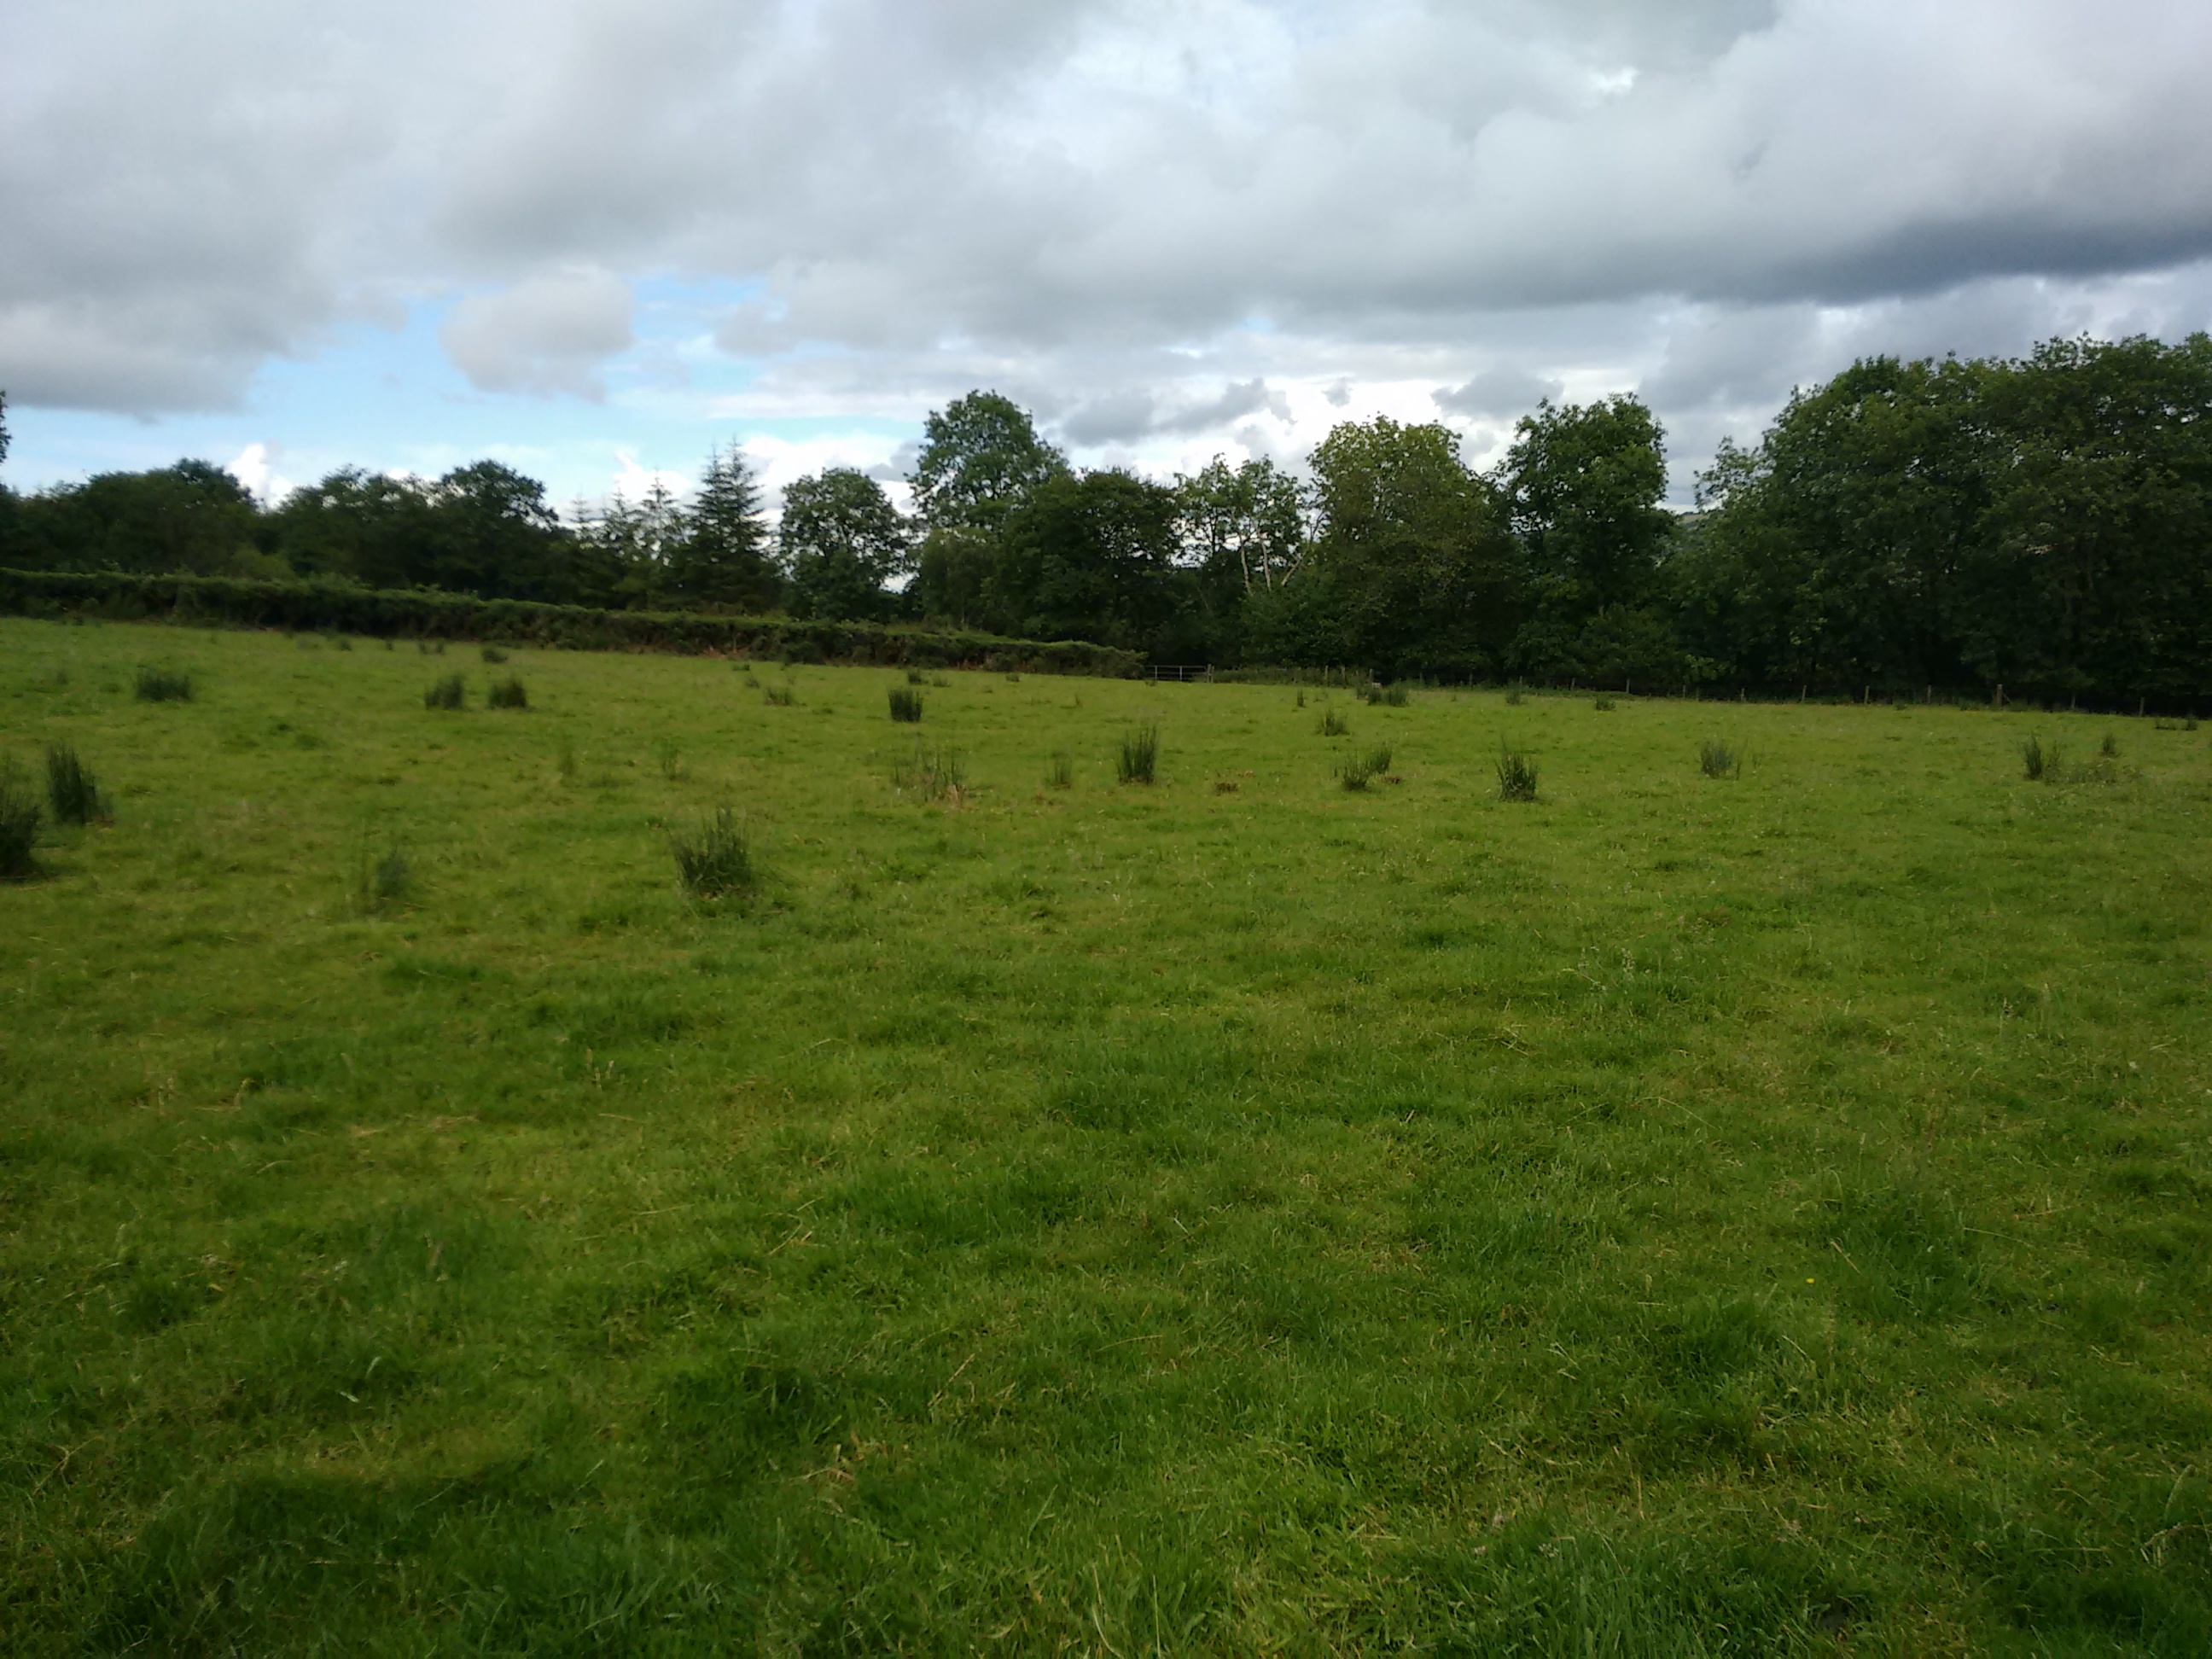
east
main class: Grassland
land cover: Grassland without tree/shrub cover
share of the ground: > 75 %
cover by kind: herbaceous plants 100 %
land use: Agriculture (excluding fallow land and kitchen gardens)
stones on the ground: 10 - 25 %
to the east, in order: Grassland without tree/shrub cover; Fences; Broadleaved woodland; Fences; Grassland without tree/shrub cover; Fences; Abandoned hedges; Ditches and canals; Grass margins; Tracks; Grass margins; Abandoned hedges; Fences; Grassland without tree/shrub cover
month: July
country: GB
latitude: 54.7632
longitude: -6.8730
